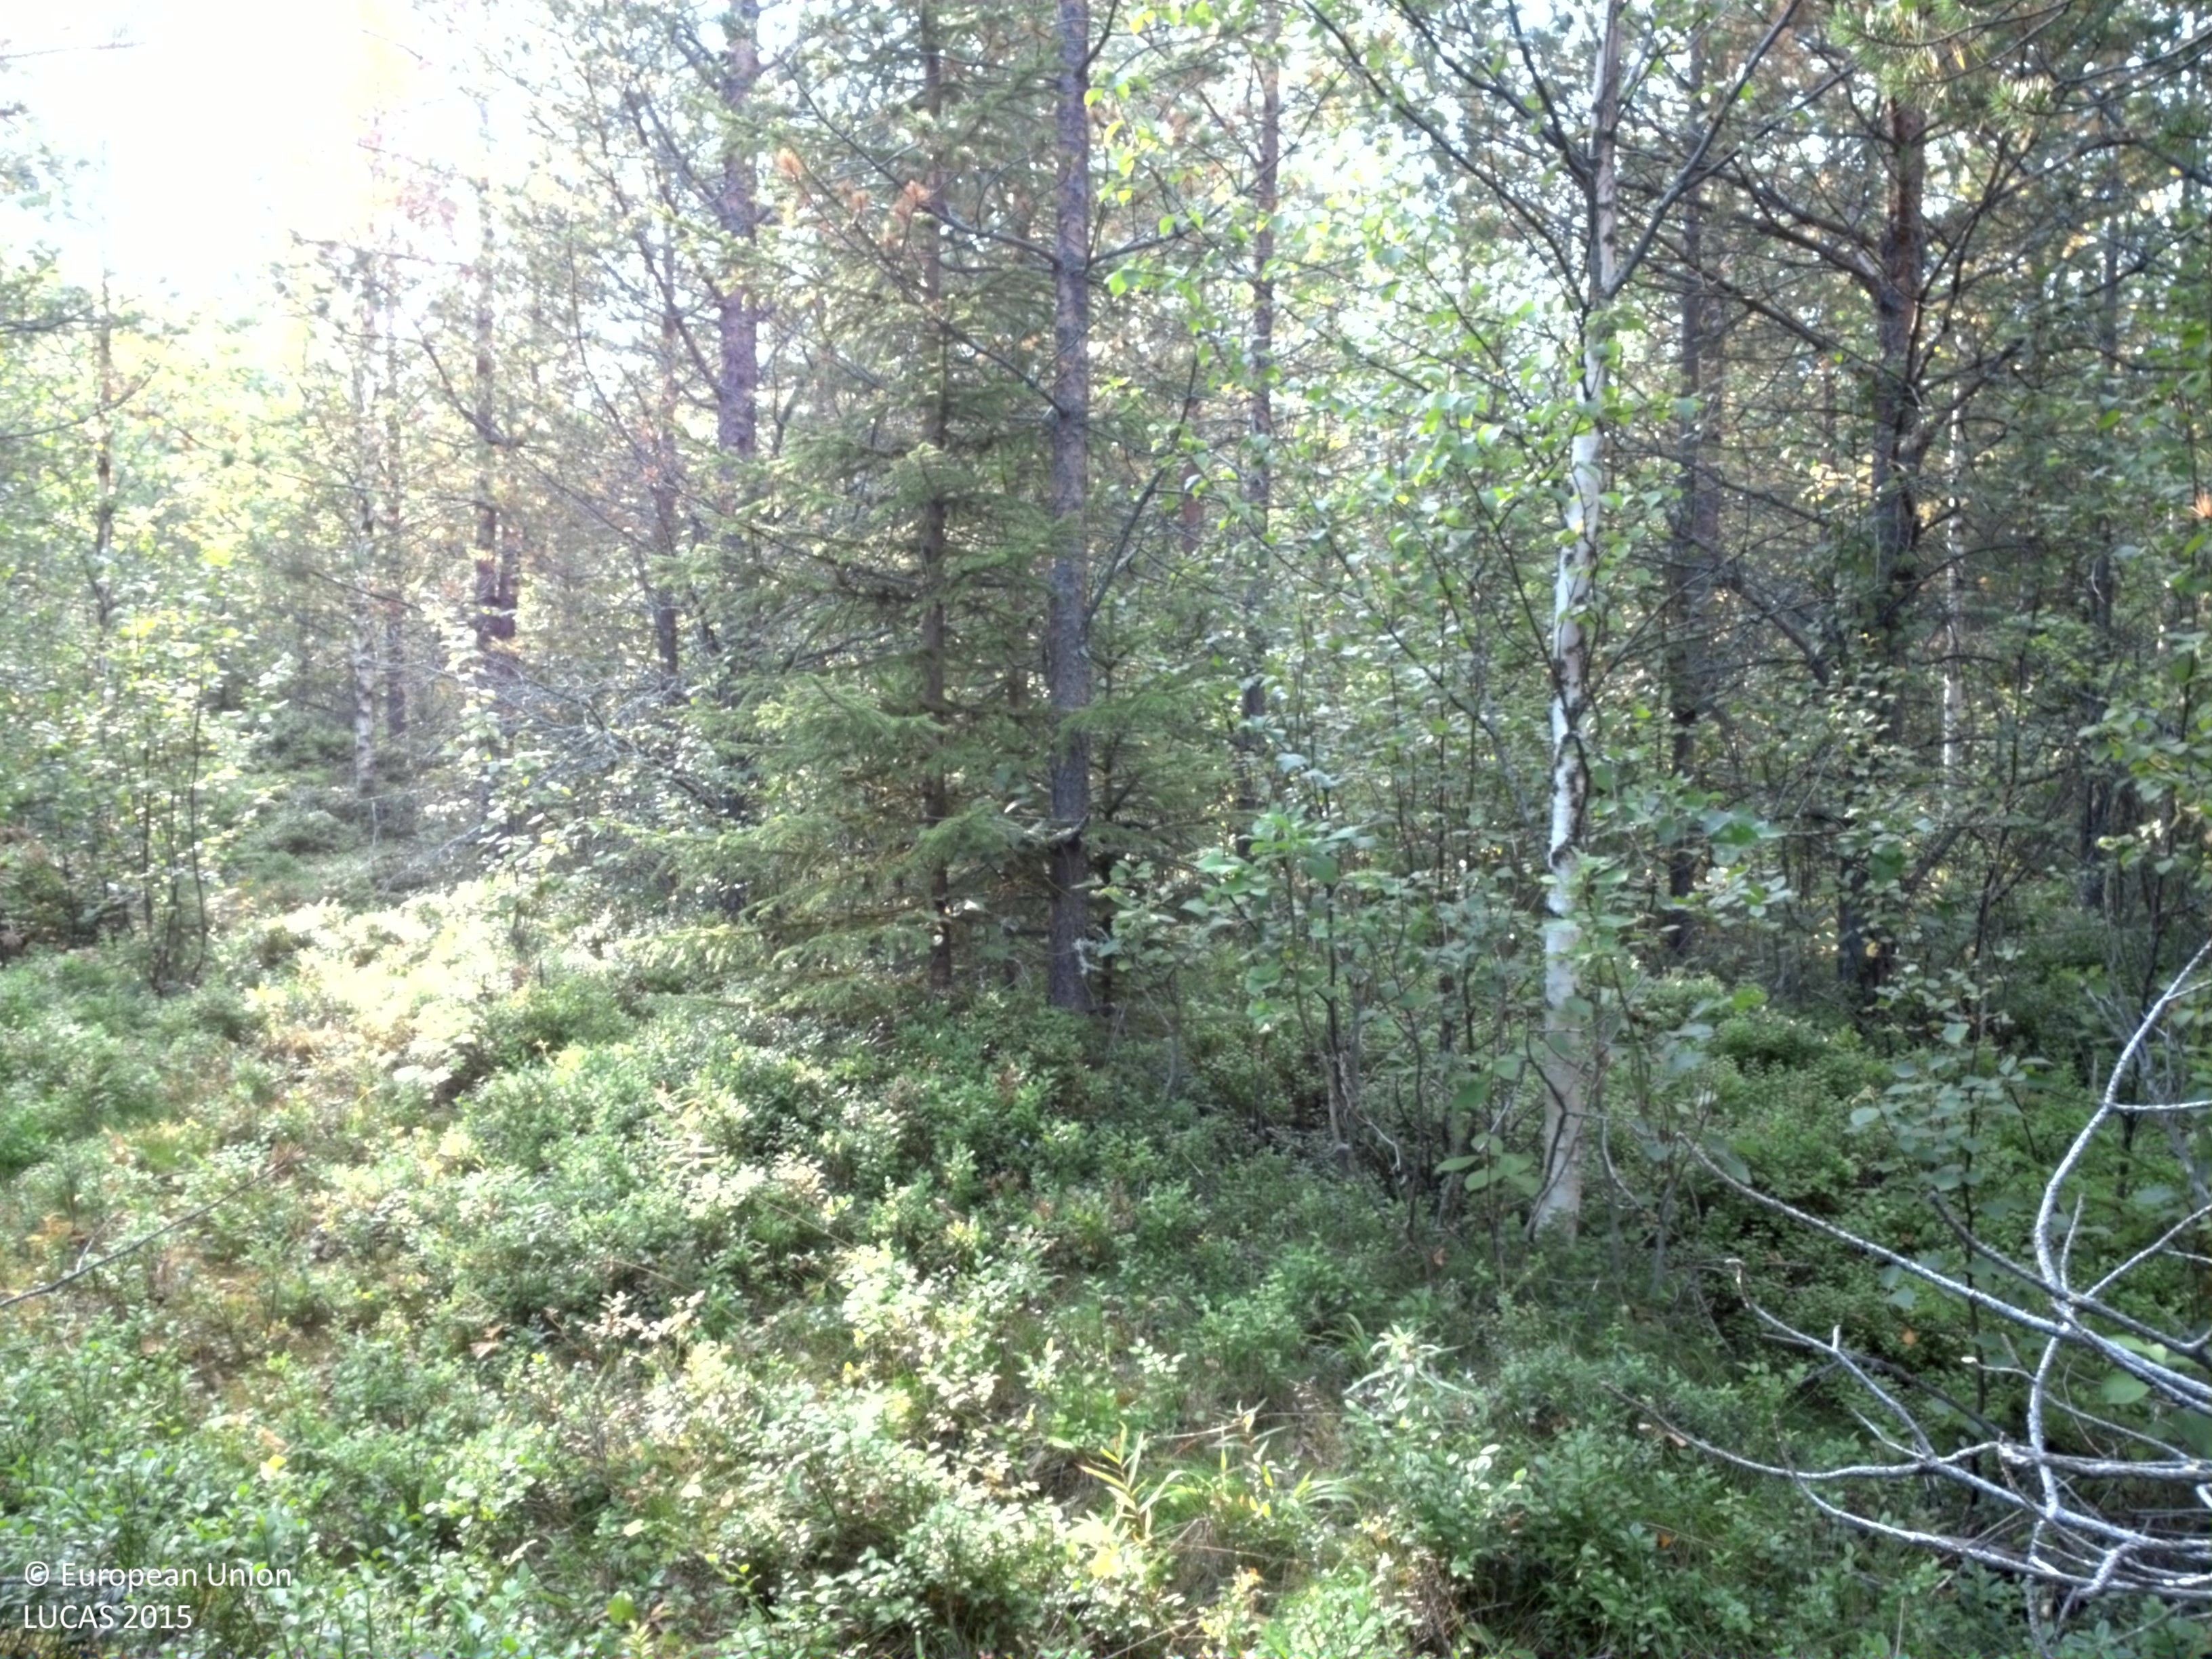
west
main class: Woodland
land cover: Pine dominated mixed woodland
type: boreal forest
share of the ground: 50 - 75 %
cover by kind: coniferous forest trees 45 %, shrubs 40 %, broadleaved forest trees 15 %
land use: Forestry
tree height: > 5 m
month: August
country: SE
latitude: 64.4401
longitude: 18.8815
